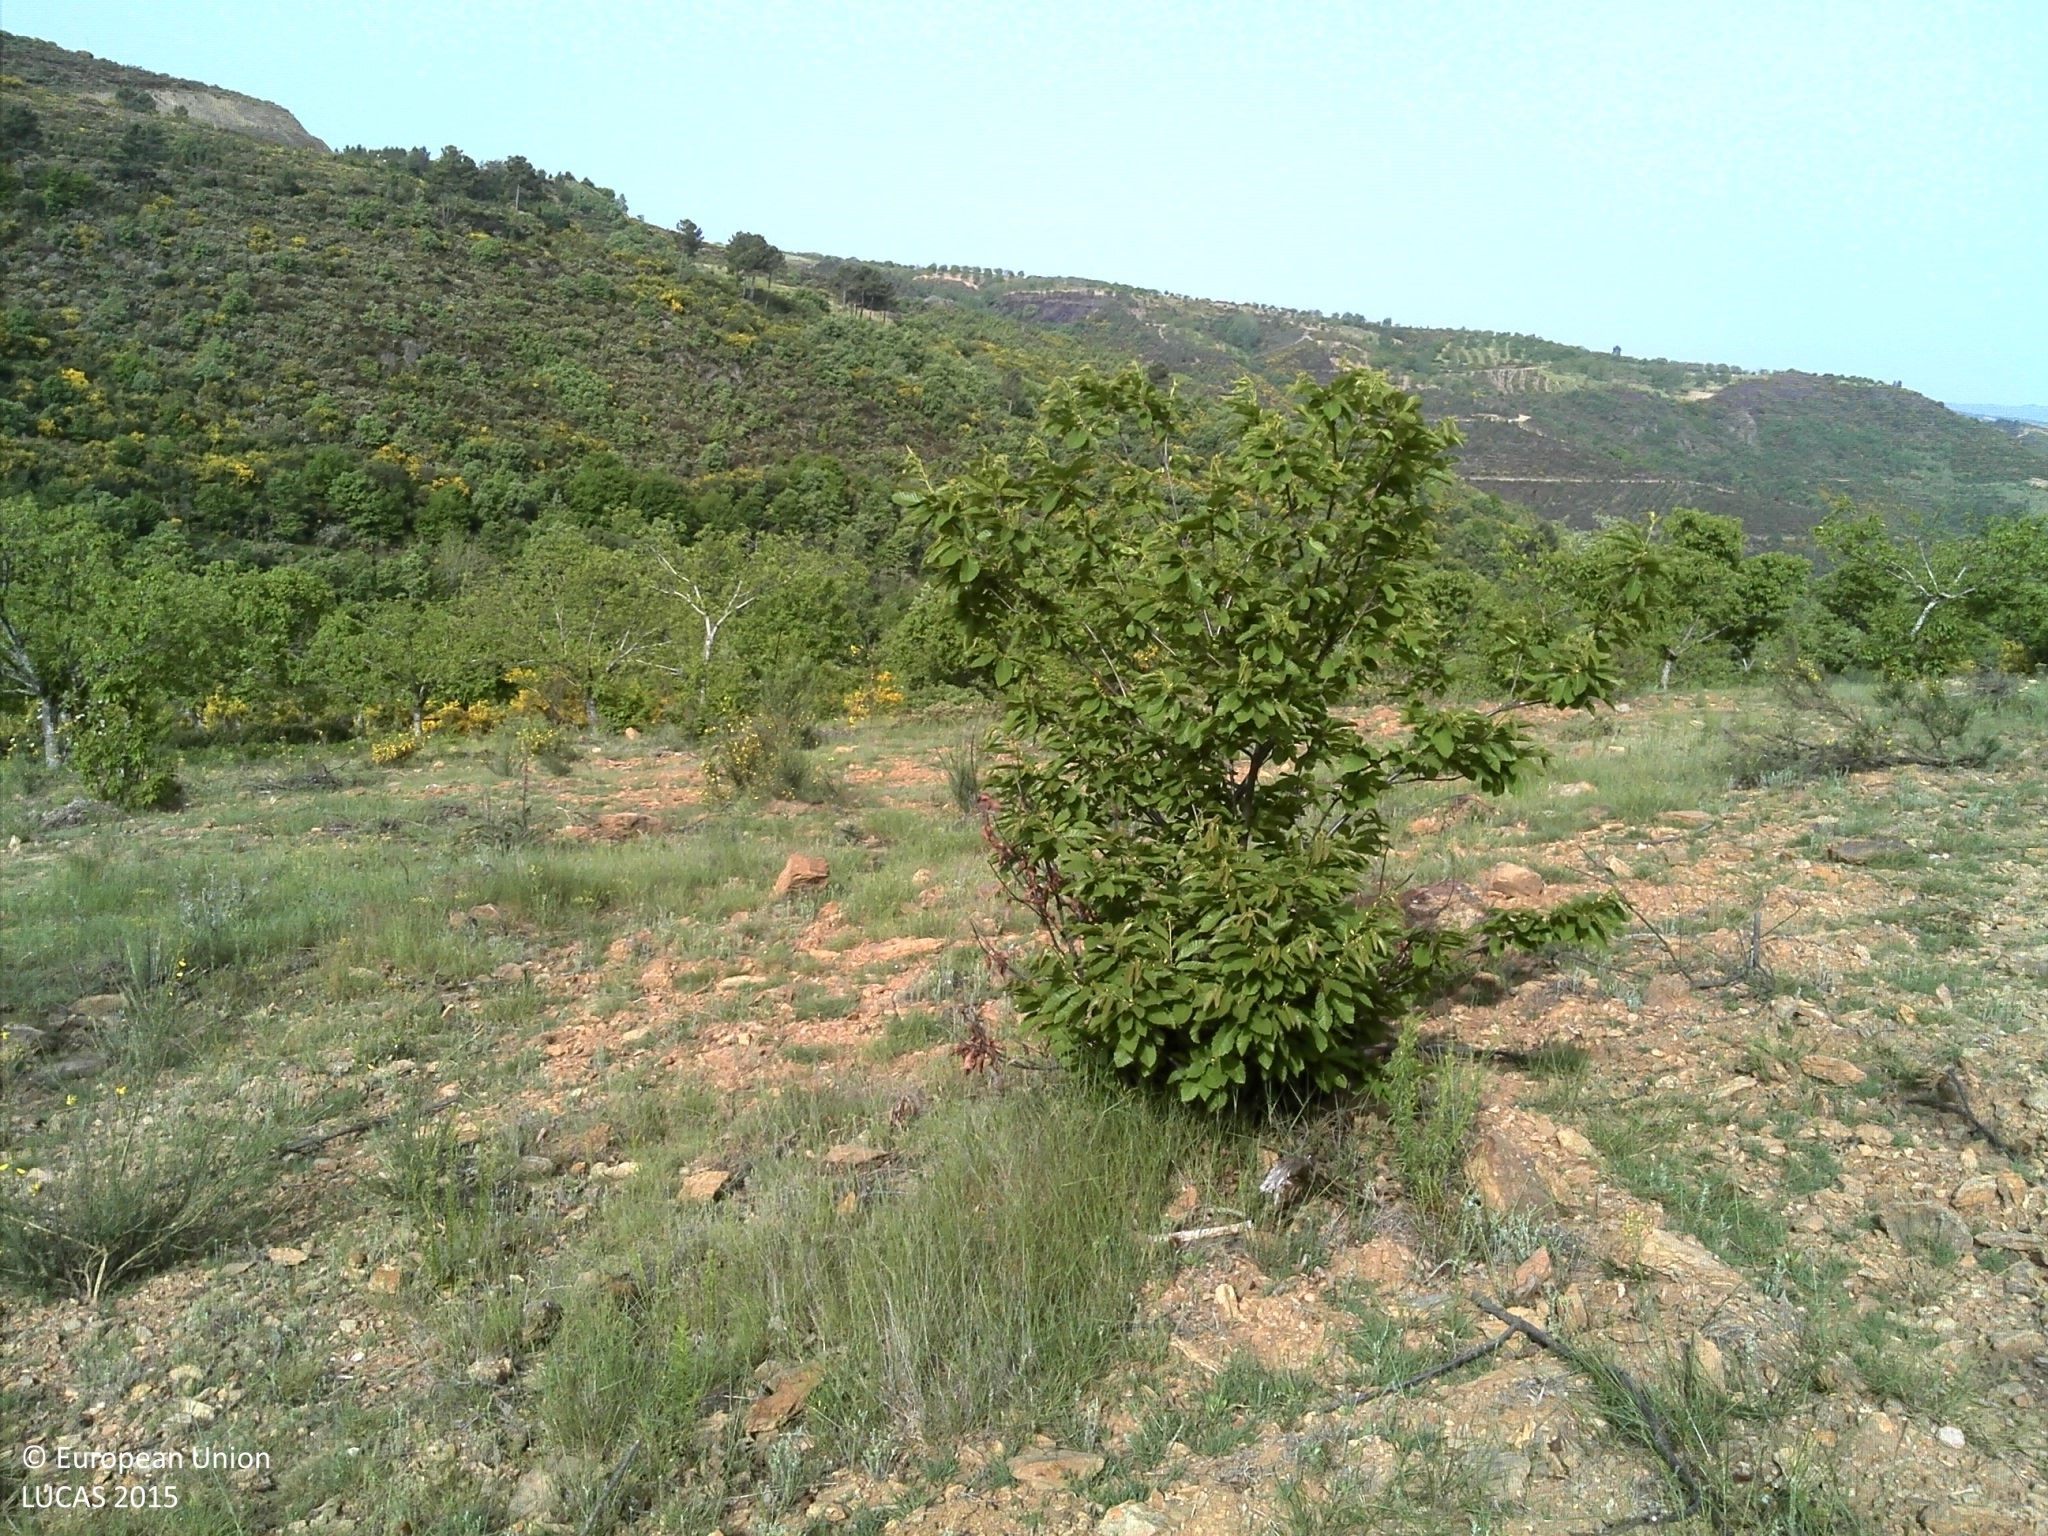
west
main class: Cropland
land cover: Nuts trees
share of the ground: 10 - 25 %
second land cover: Grassland without tree/shrub cover
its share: 10 - 25 %
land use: Agriculture (excluding fallow land and kitchen gardens)
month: May
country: PT
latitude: 41.8379
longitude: -7.0647
